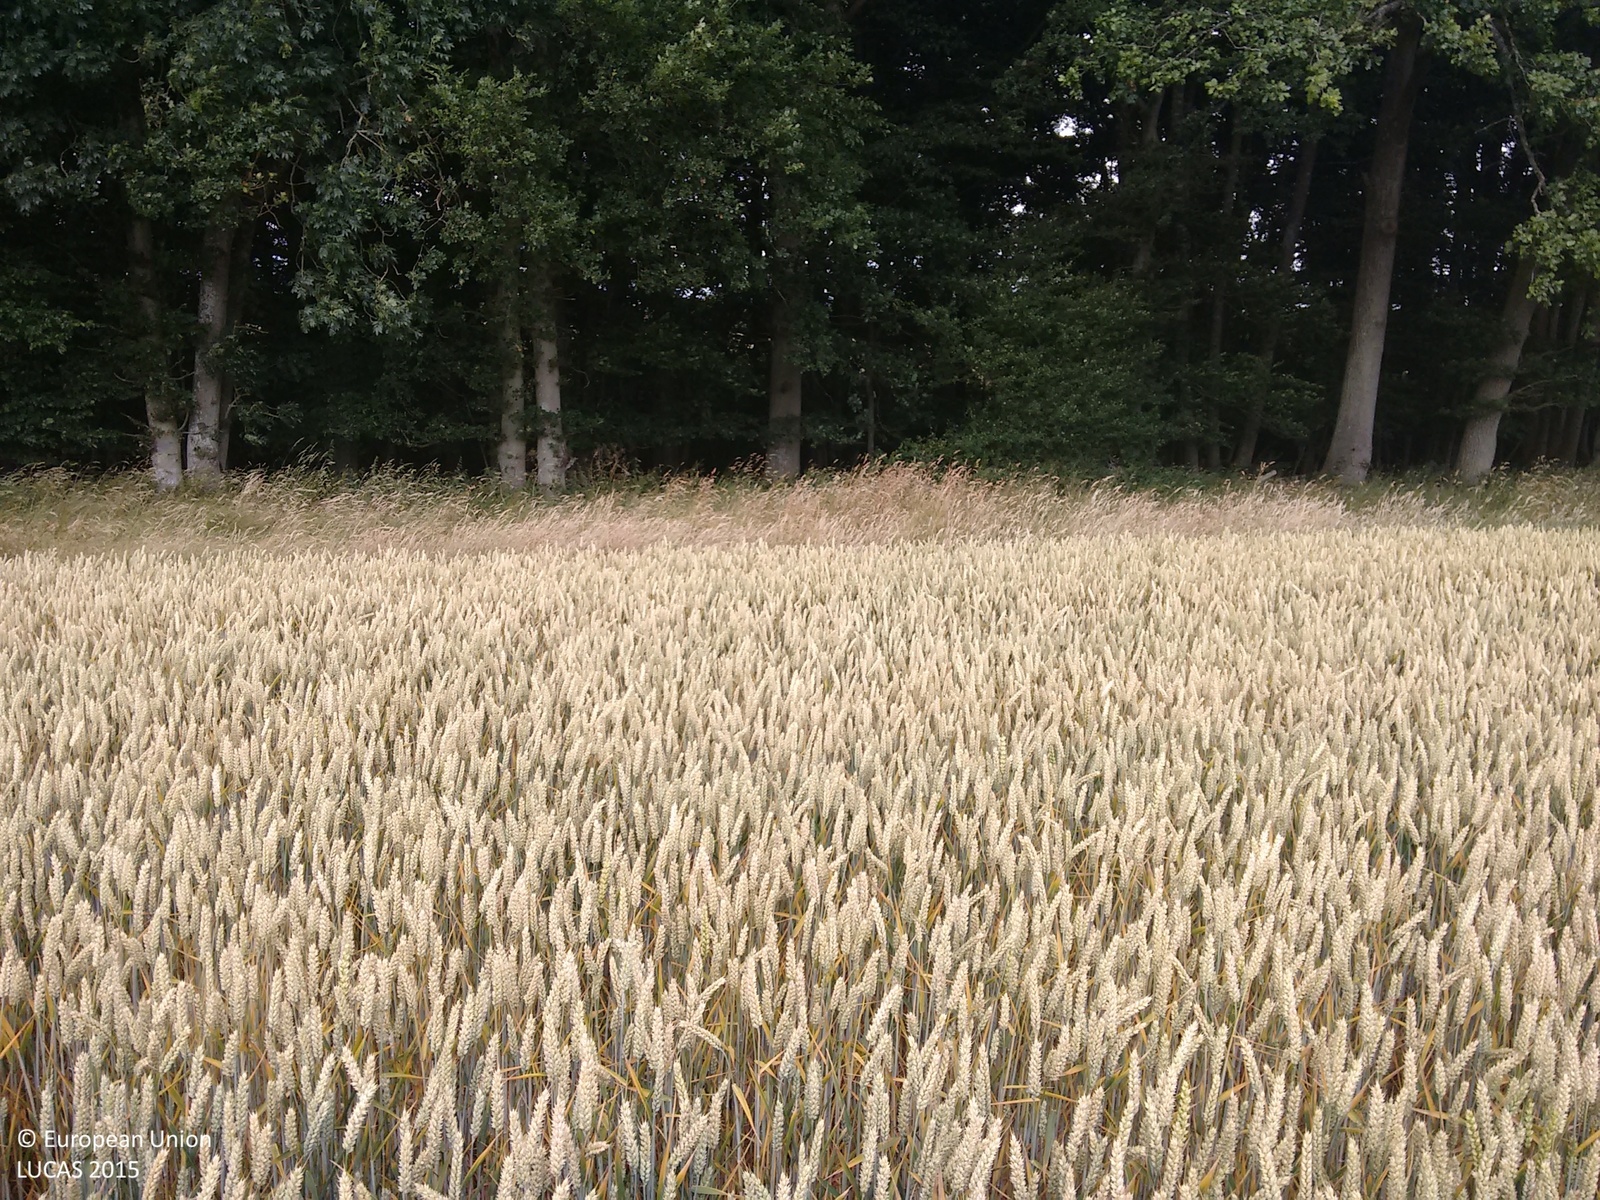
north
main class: Cropland
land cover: Common wheat
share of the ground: 50 - 75 %
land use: Agriculture (excluding fallow land and kitchen gardens)
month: July
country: GB
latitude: 51.0585
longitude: -0.4965
